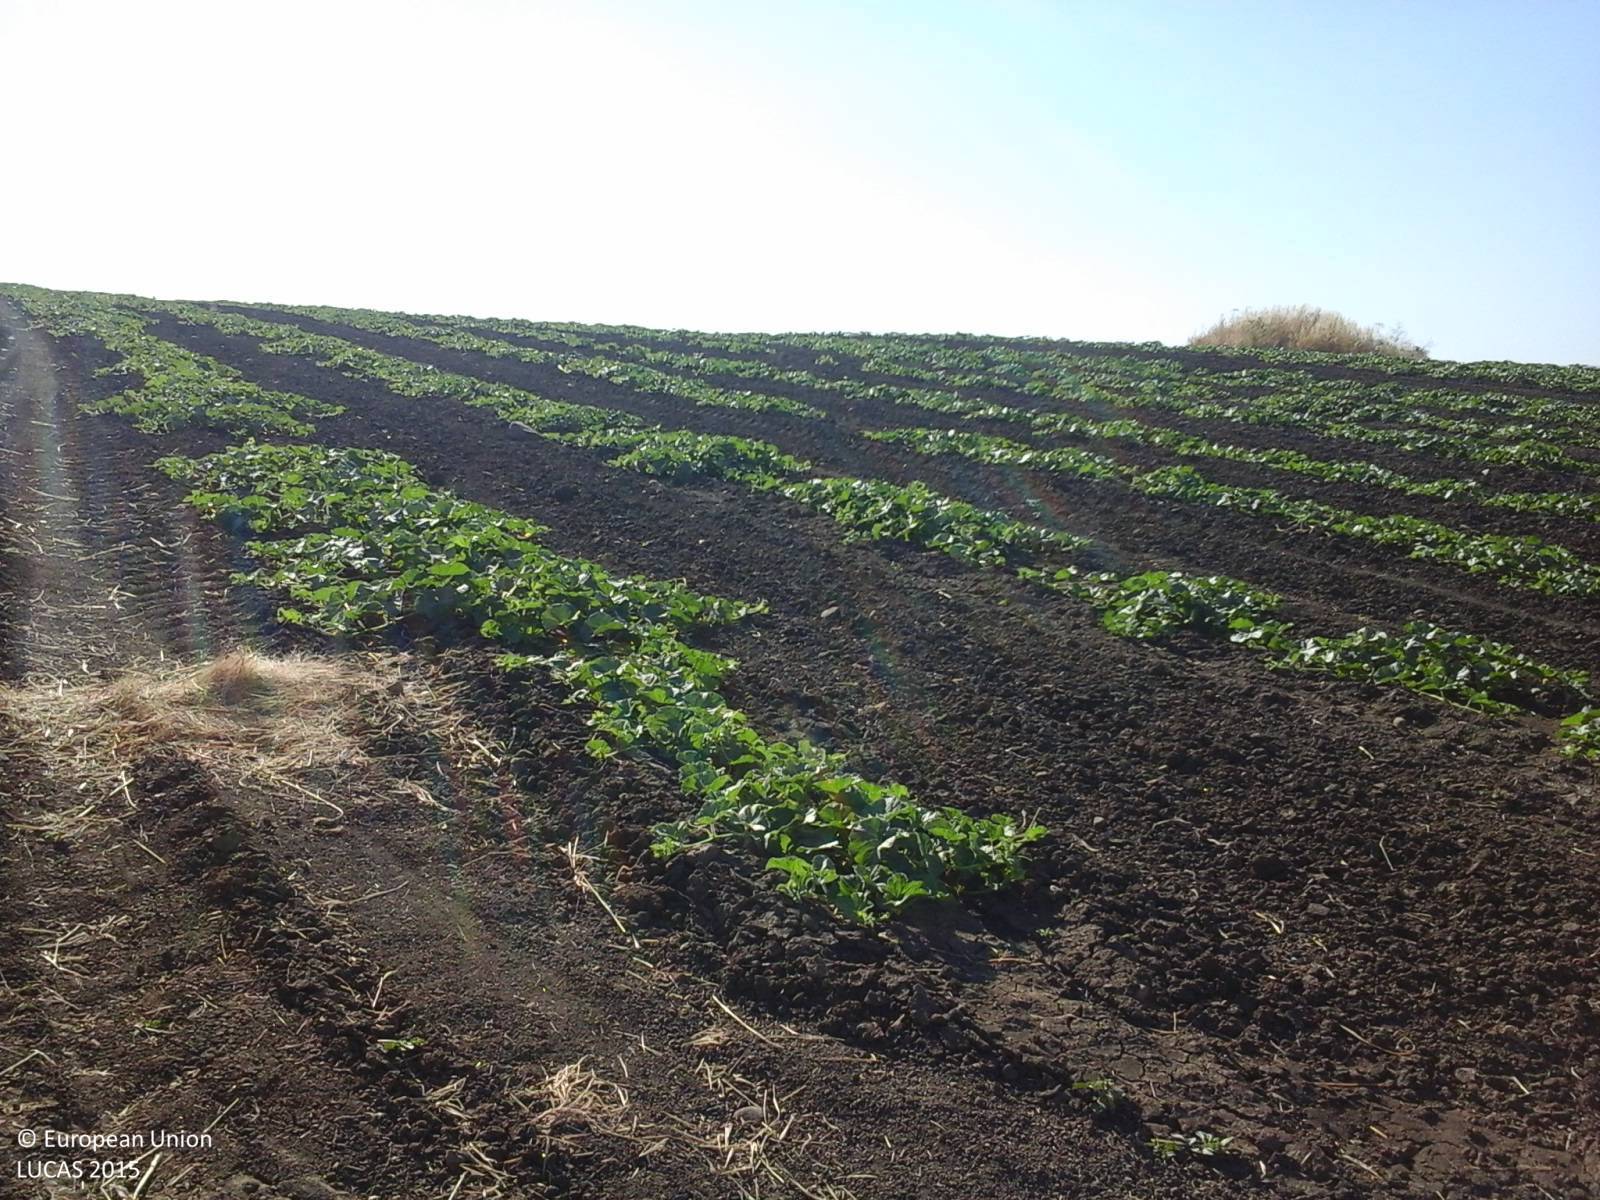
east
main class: Cropland
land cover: Dry pulses
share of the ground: > 75 %
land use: Agriculture (excluding fallow land and kitchen gardens)
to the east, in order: Dry pulses; Ditches and canals; Other fresh vegetables
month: July
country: IT
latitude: 37.8452
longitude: 13.0121
